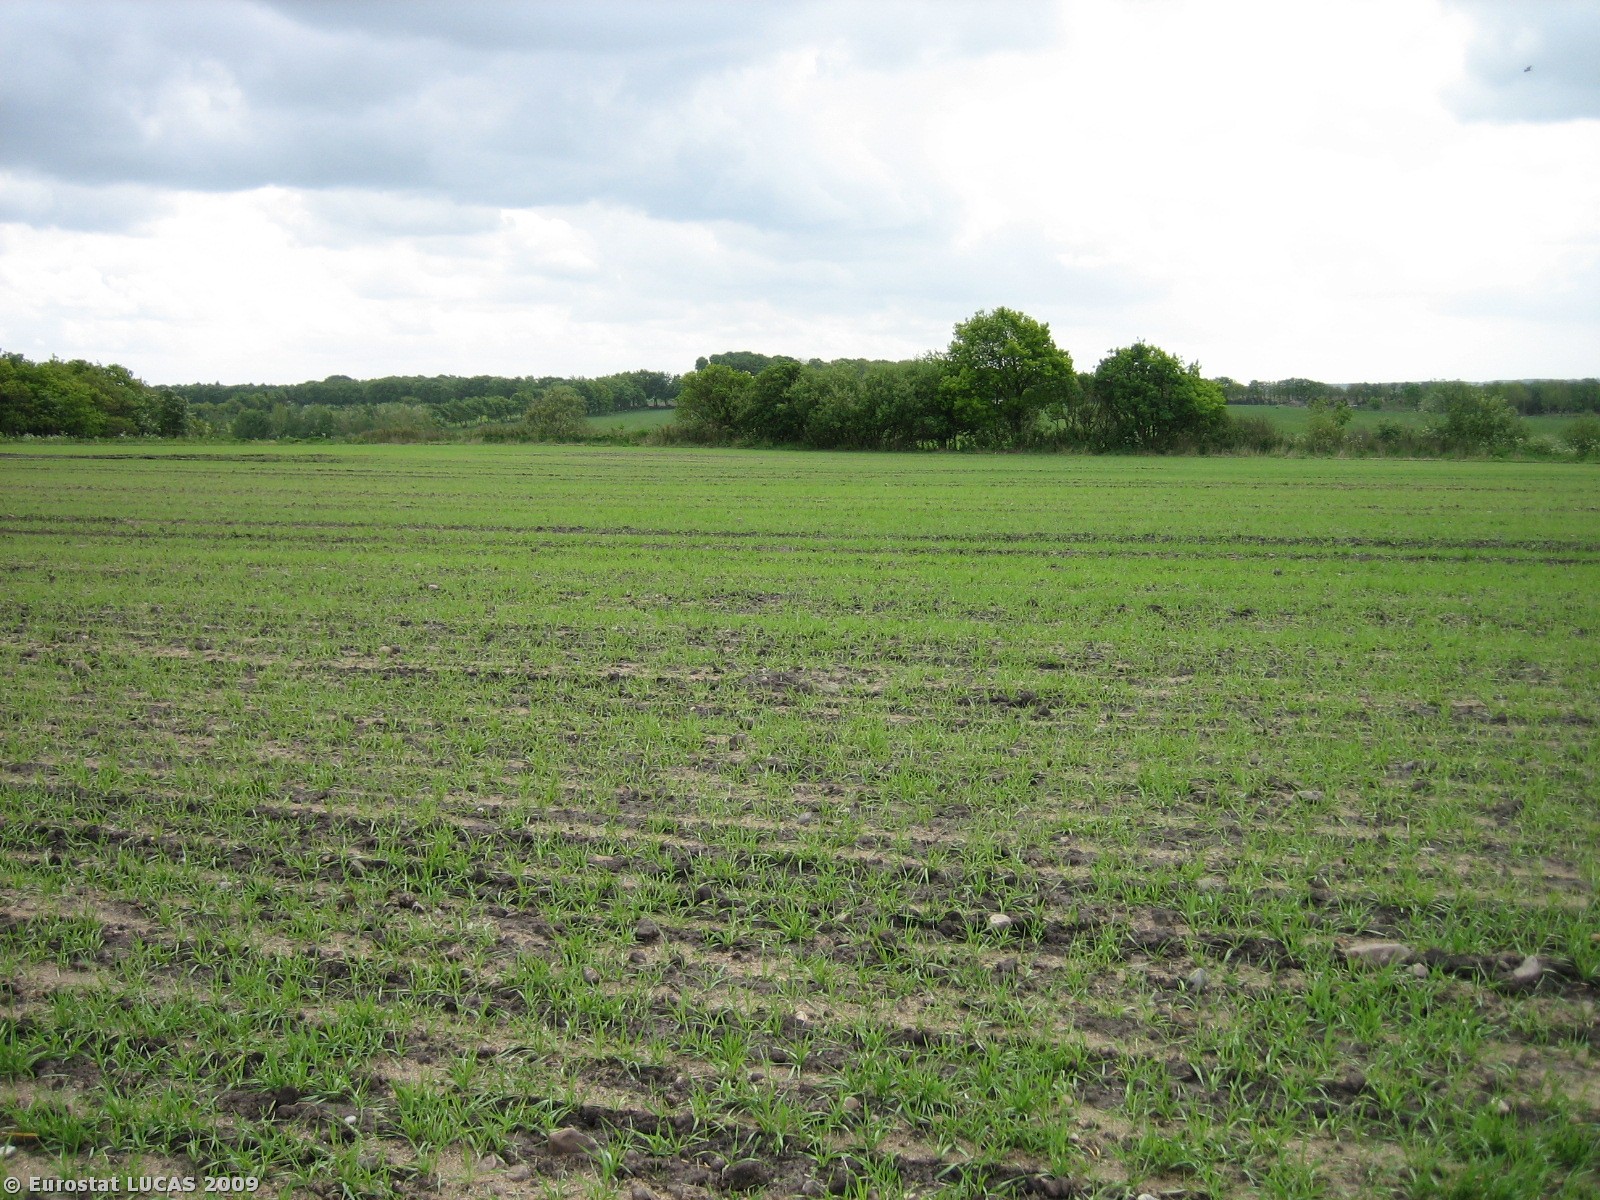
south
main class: Cropland
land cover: Barley
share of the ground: 50 - 75 %
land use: Agriculture (excluding fallow land and kitchen gardens)
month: May
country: DK
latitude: 56.1829
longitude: 8.8896
